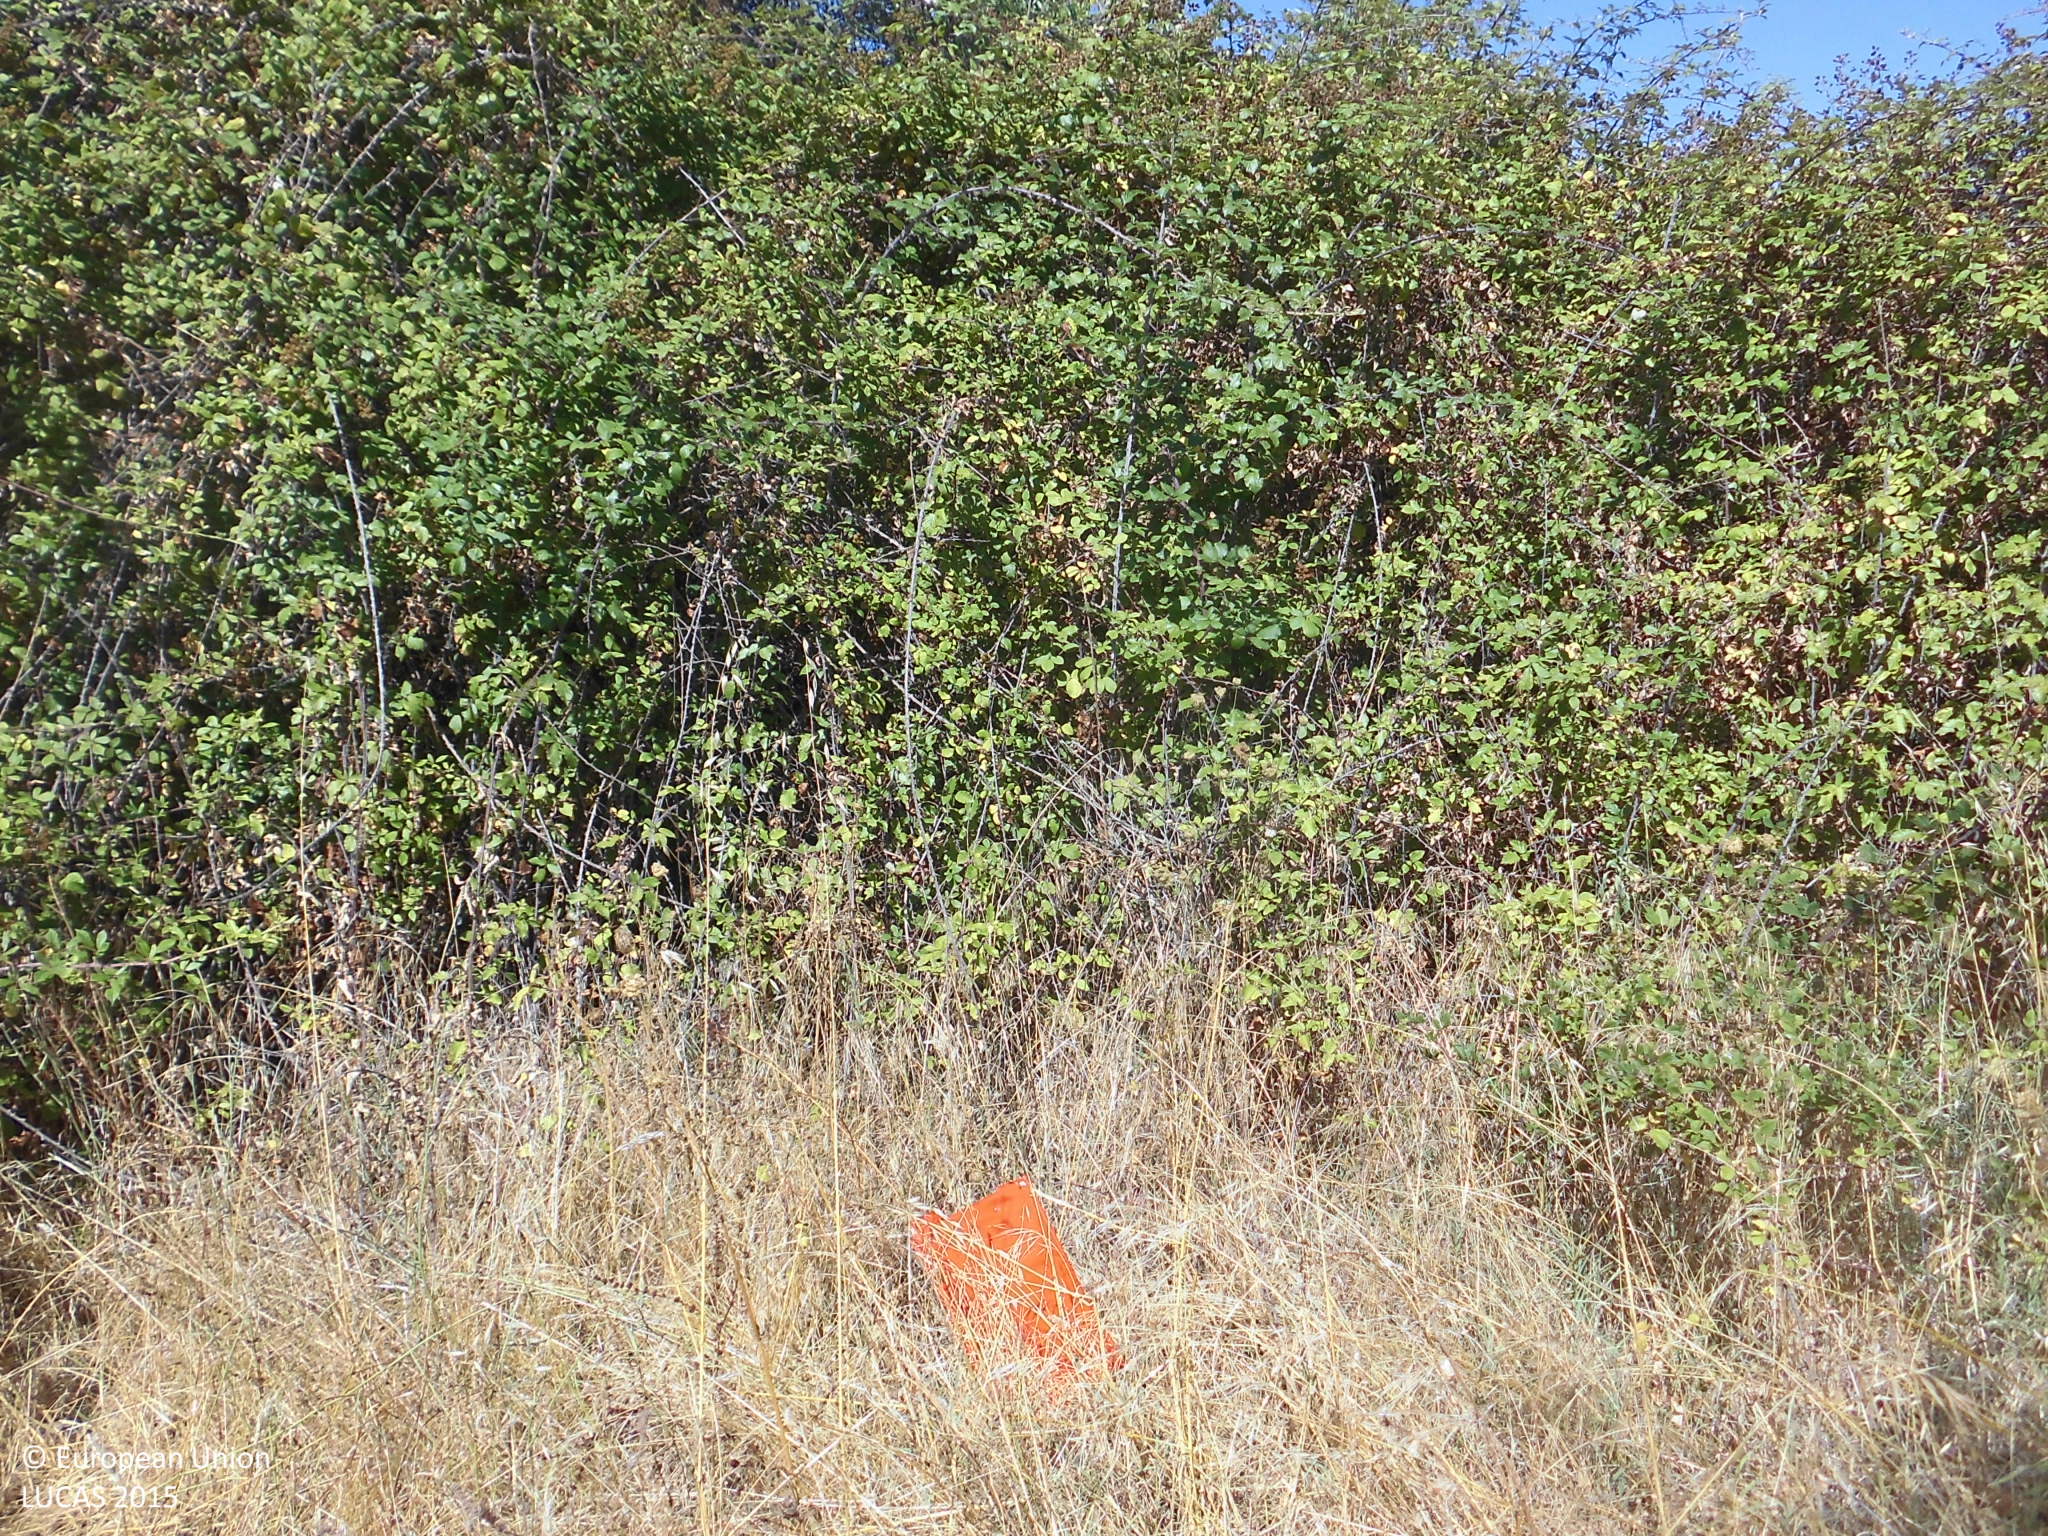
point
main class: Shrubland
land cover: Shrubland with sparse tree cover
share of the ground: > 75 %
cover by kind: herbaceous plants 65 %, shrubs 30 %, broadleaved forest trees 5 %
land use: Semi-natural and natural areas not in use
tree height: > 5 m
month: July
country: ES
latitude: 40.0826
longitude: -6.1279
